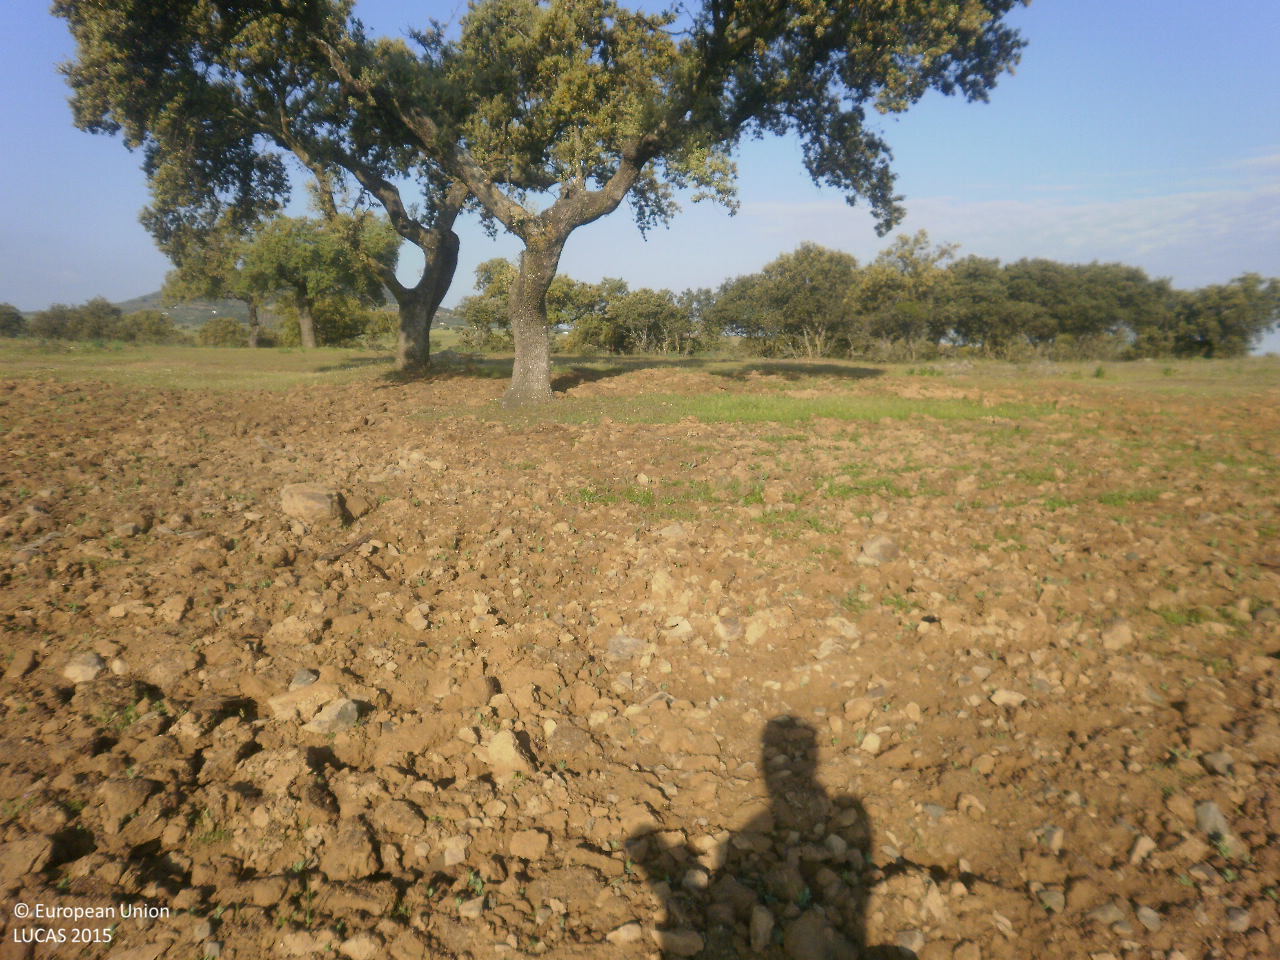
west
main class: Cropland
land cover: Dry pulses
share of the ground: < 10 %
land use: Agriculture (excluding fallow land and kitchen gardens)
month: April
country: ES
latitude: 38.7428
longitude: -5.2101
